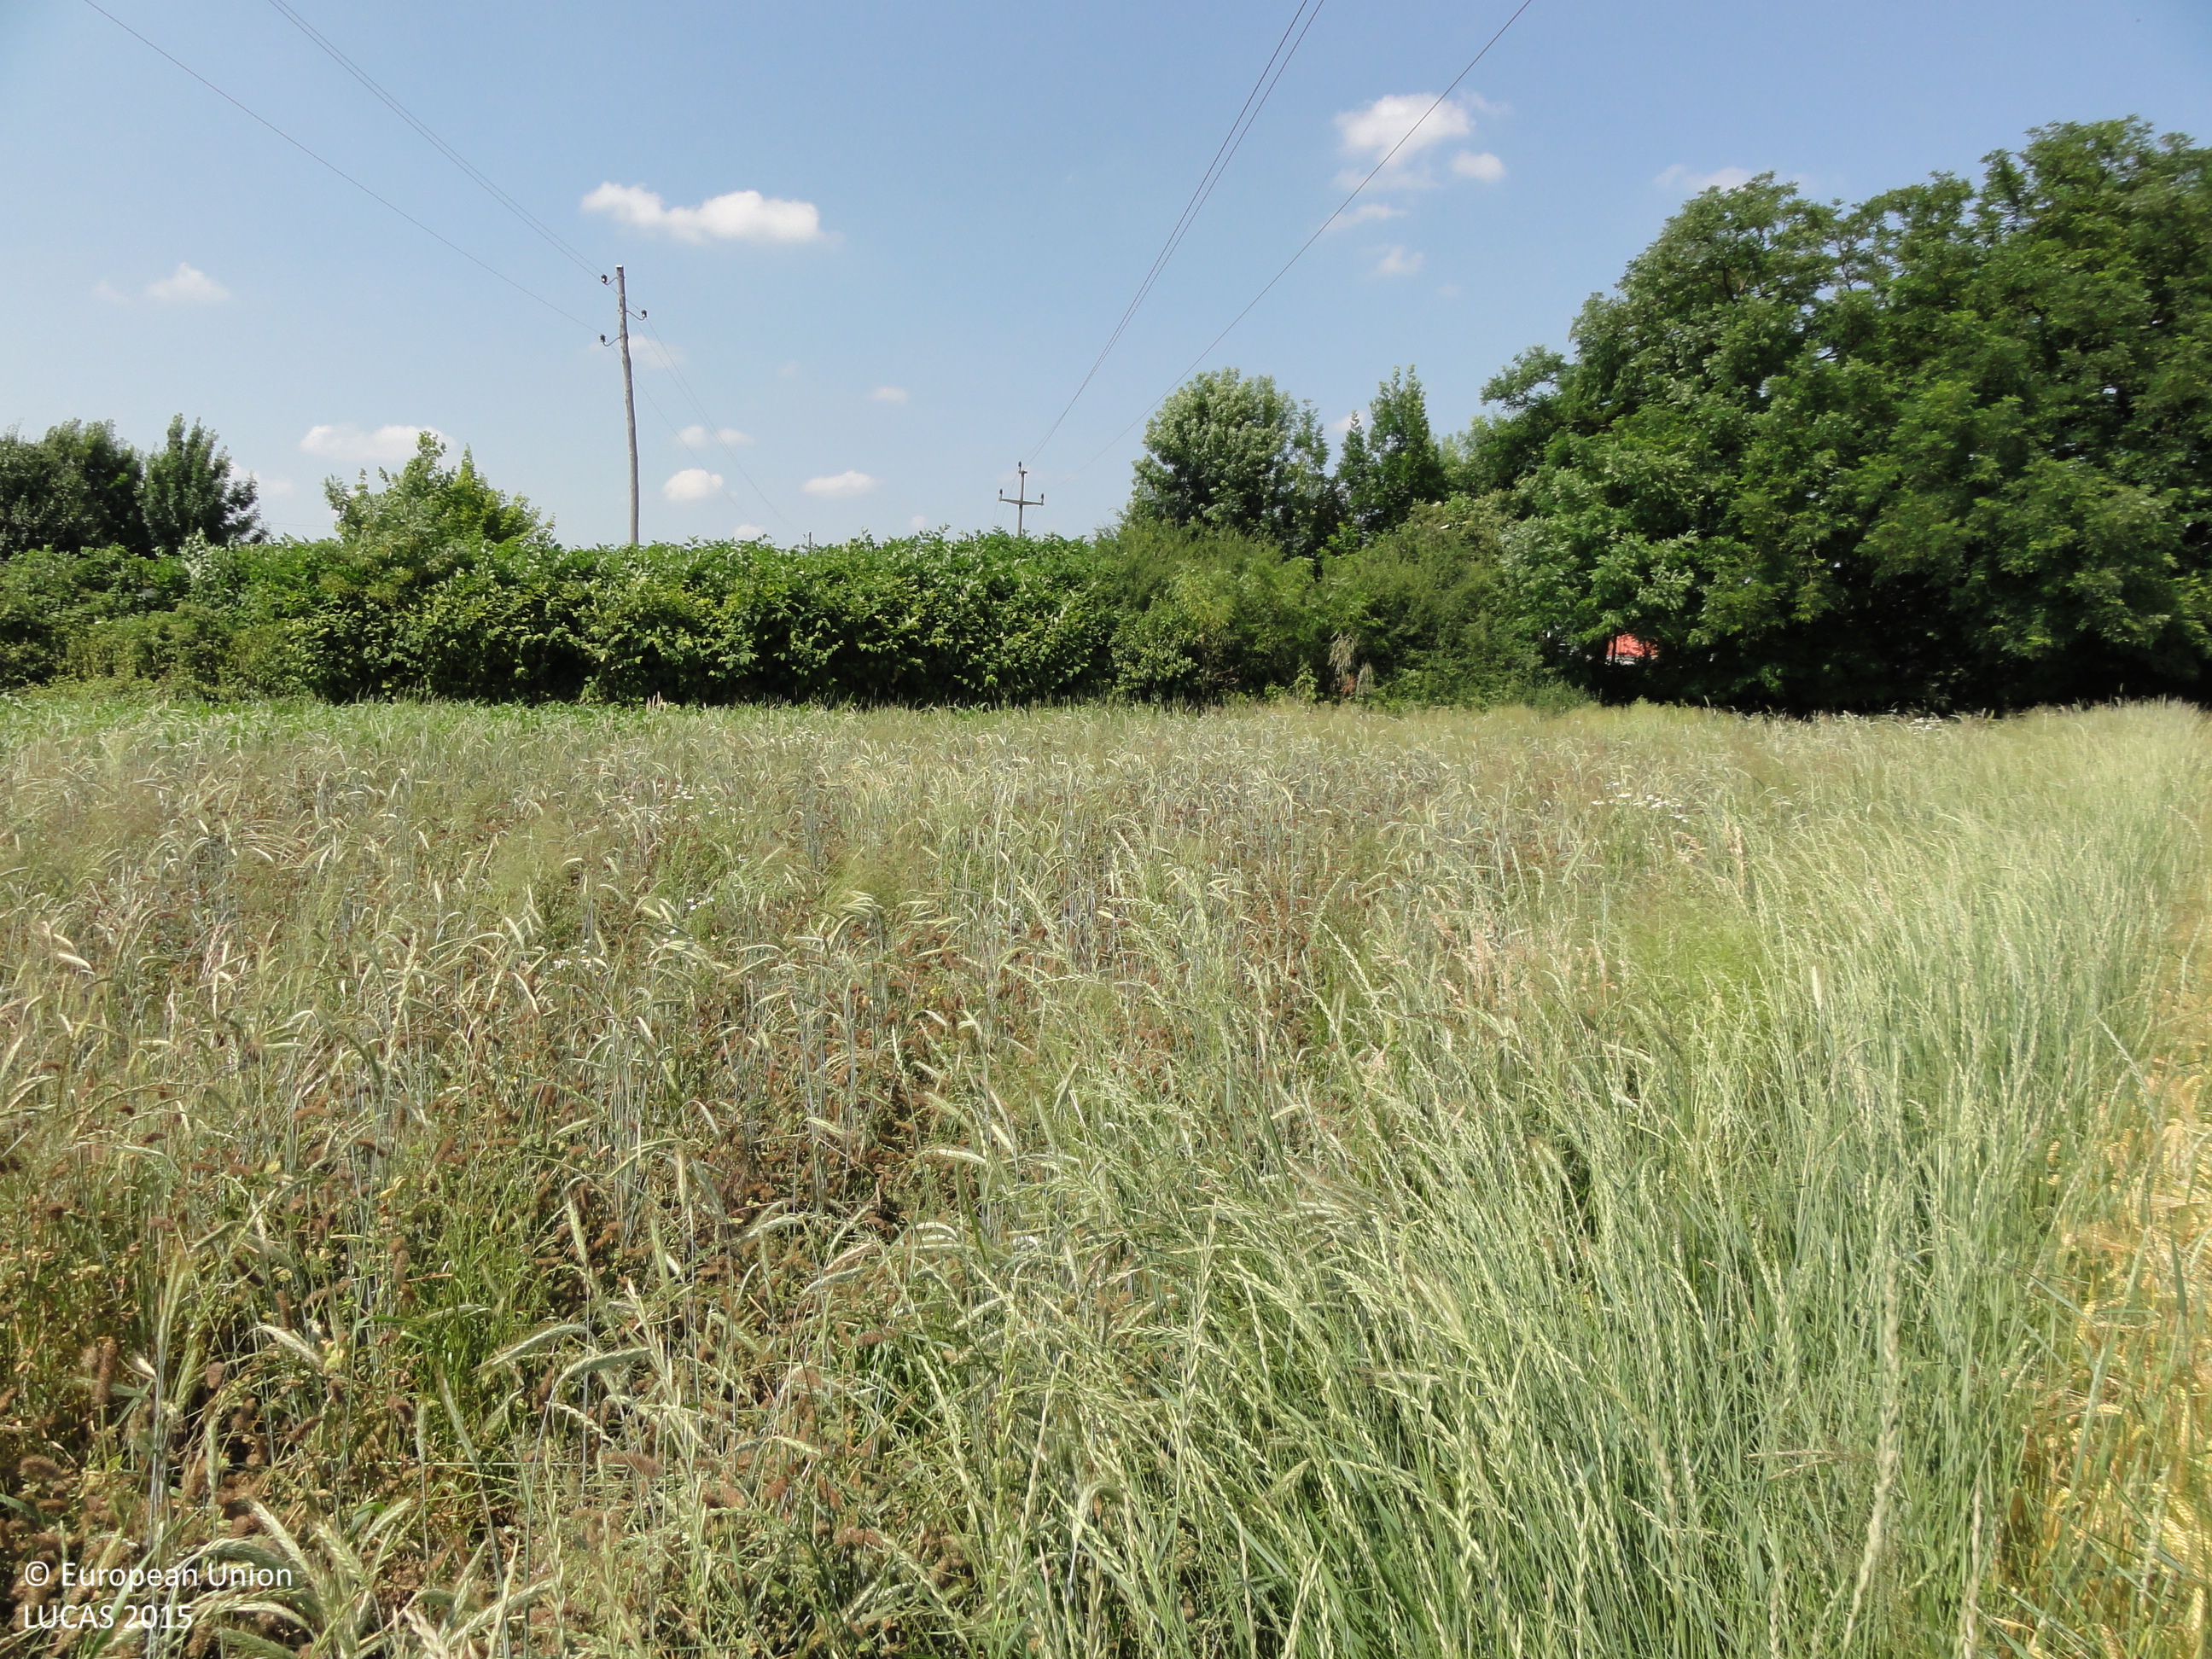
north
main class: Cropland
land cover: Barley
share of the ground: > 75 %
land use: Agriculture (excluding fallow land and kitchen gardens)
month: June
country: SI
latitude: 46.6600
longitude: 16.1821
